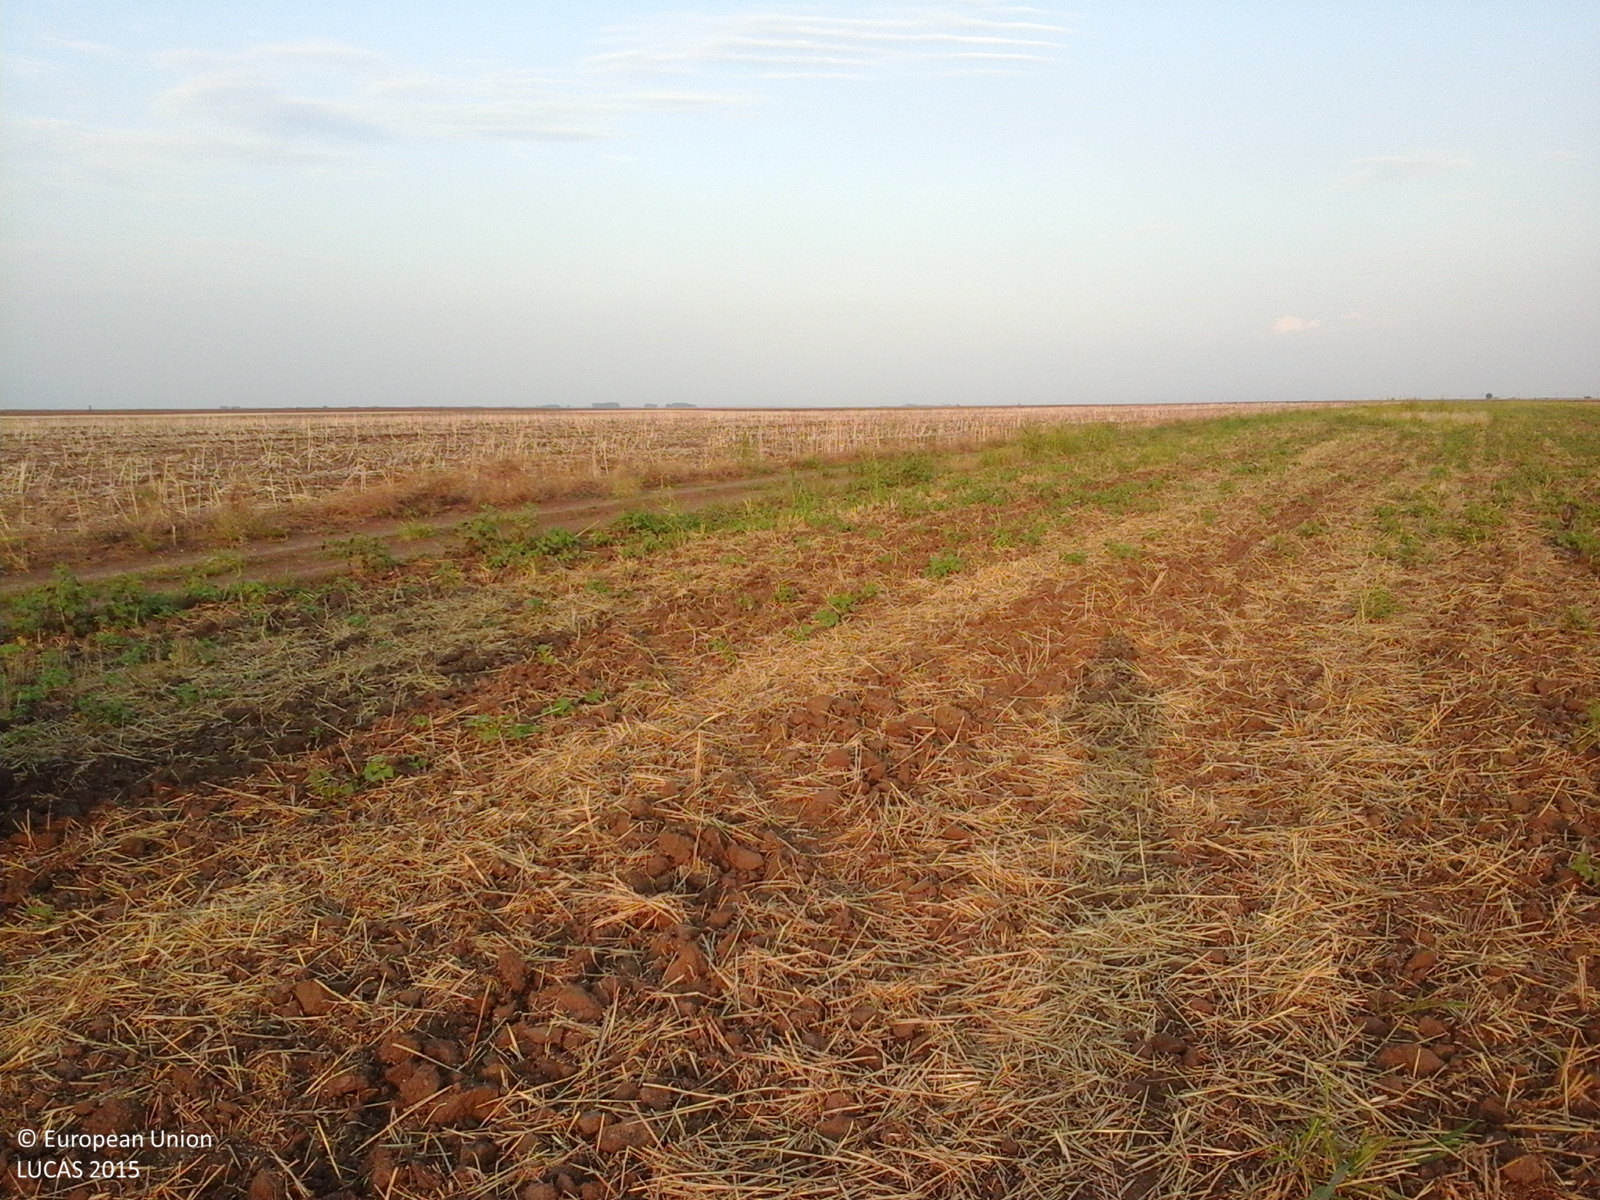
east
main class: Cropland
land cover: Common wheat
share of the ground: 50 - 75 %
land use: Agriculture (excluding fallow land and kitchen gardens)
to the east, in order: Common wheat; Tracks; Rape and turnip rape
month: August
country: RO
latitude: 44.0137
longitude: 23.2044
